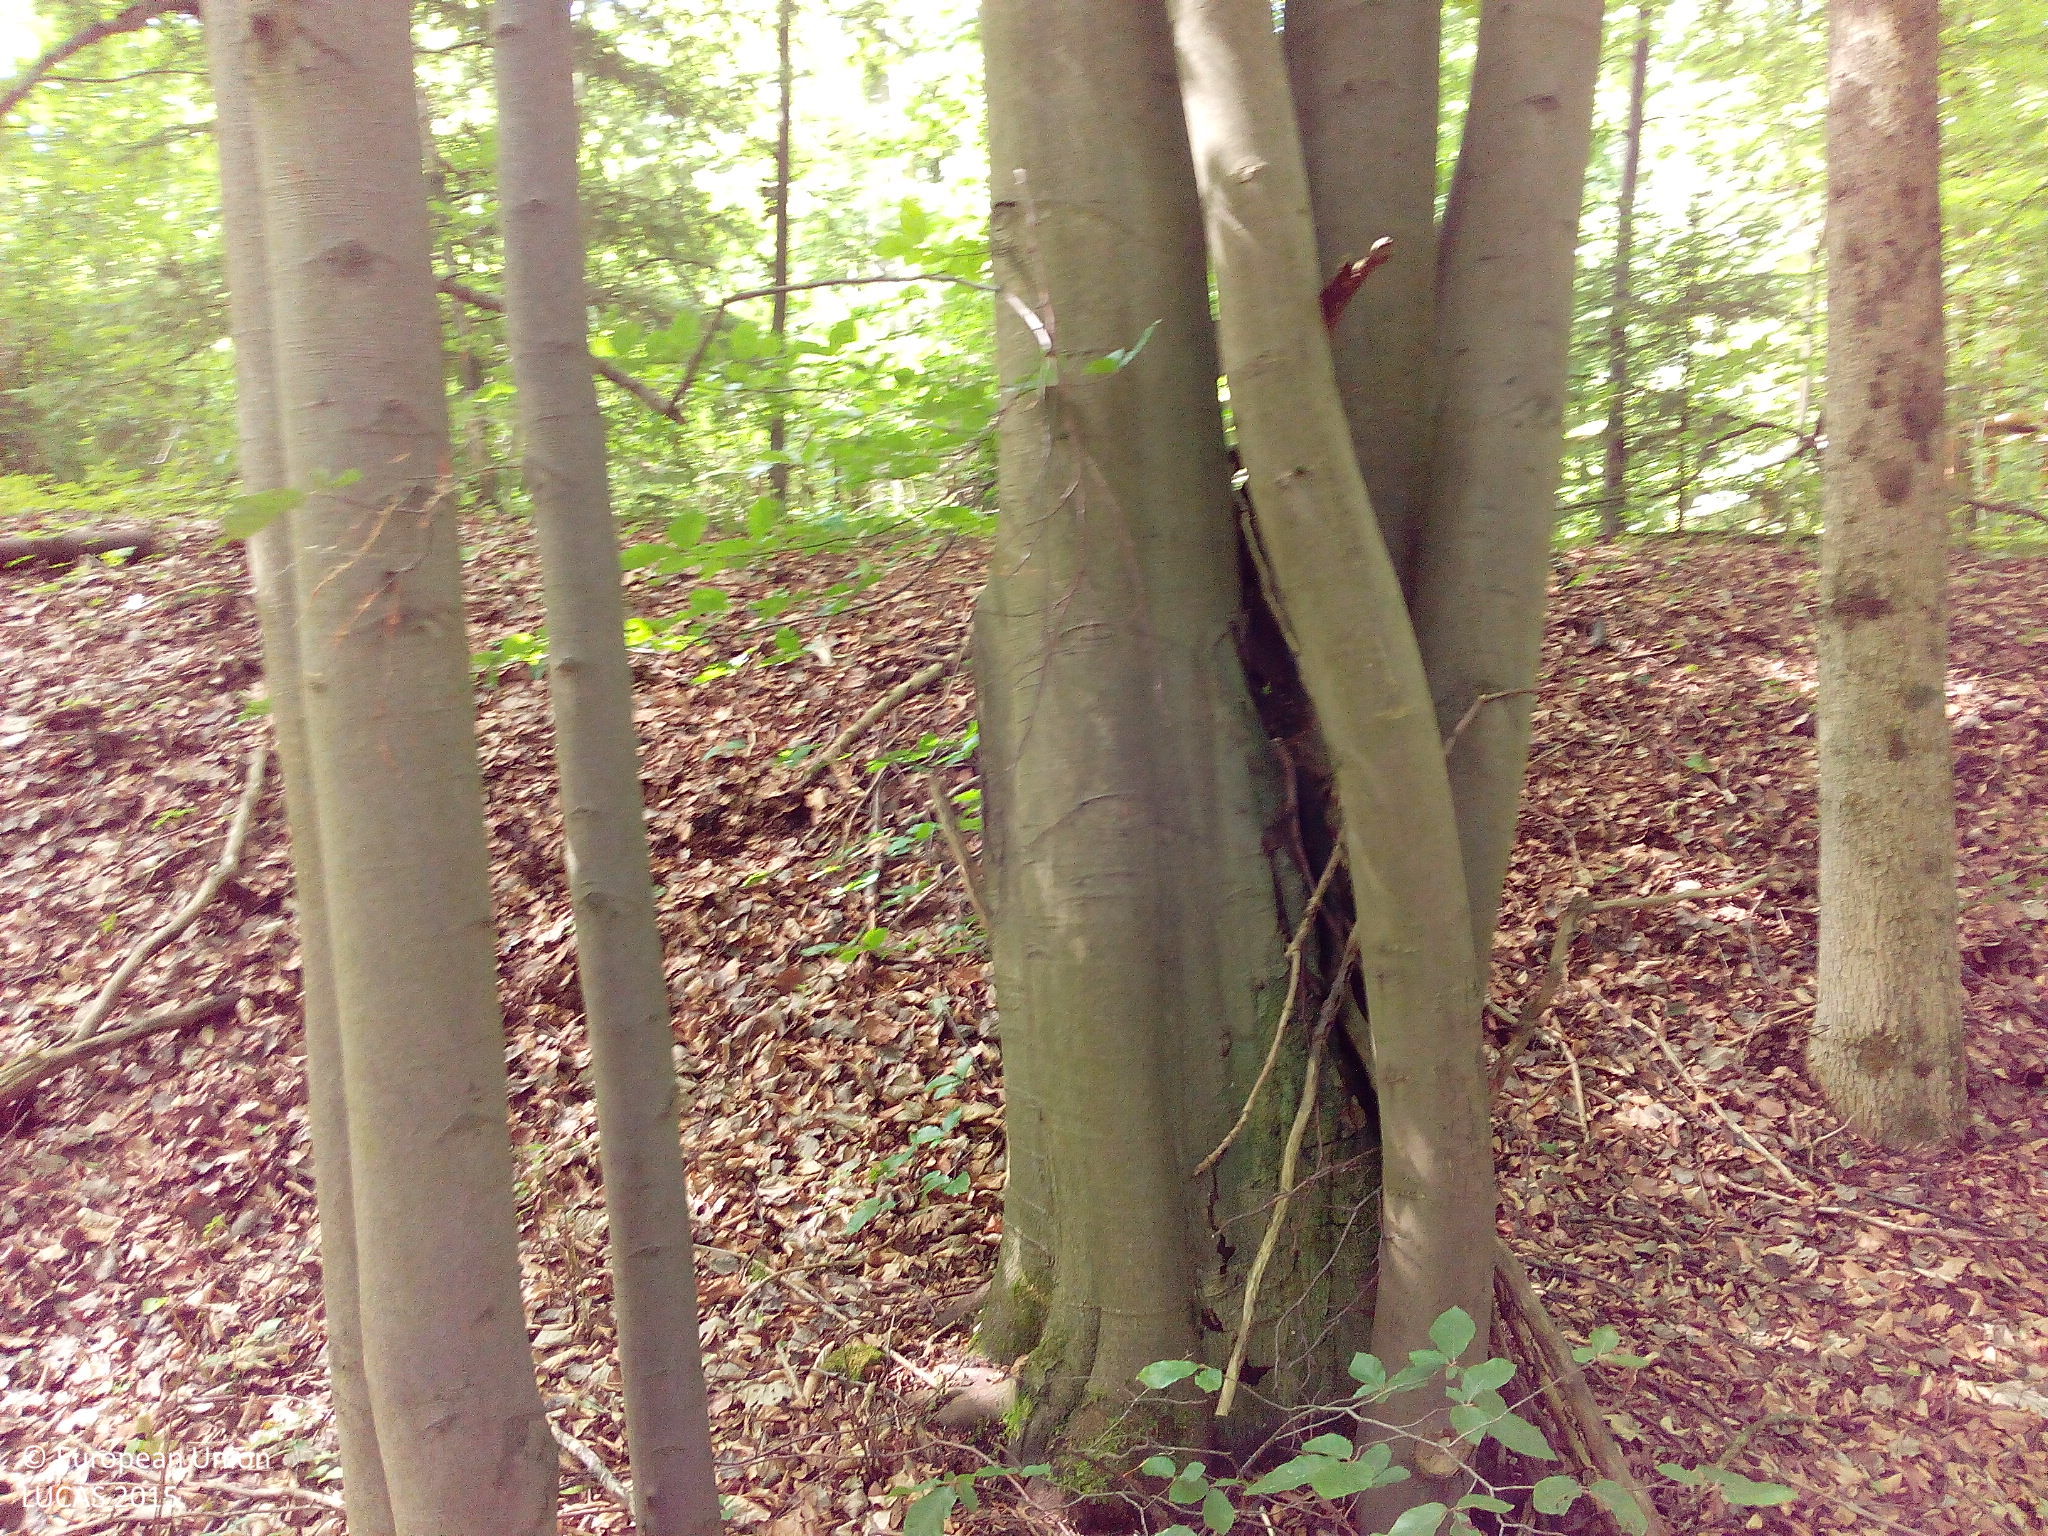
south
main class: Woodland
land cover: Broadleaved woodland
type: beech forest
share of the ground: > 75 %
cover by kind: broadleaved forest trees 100 %
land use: Forestry
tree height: > 5 m
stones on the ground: < 10 %
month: July
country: DE
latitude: 50.9933
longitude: 9.9288
